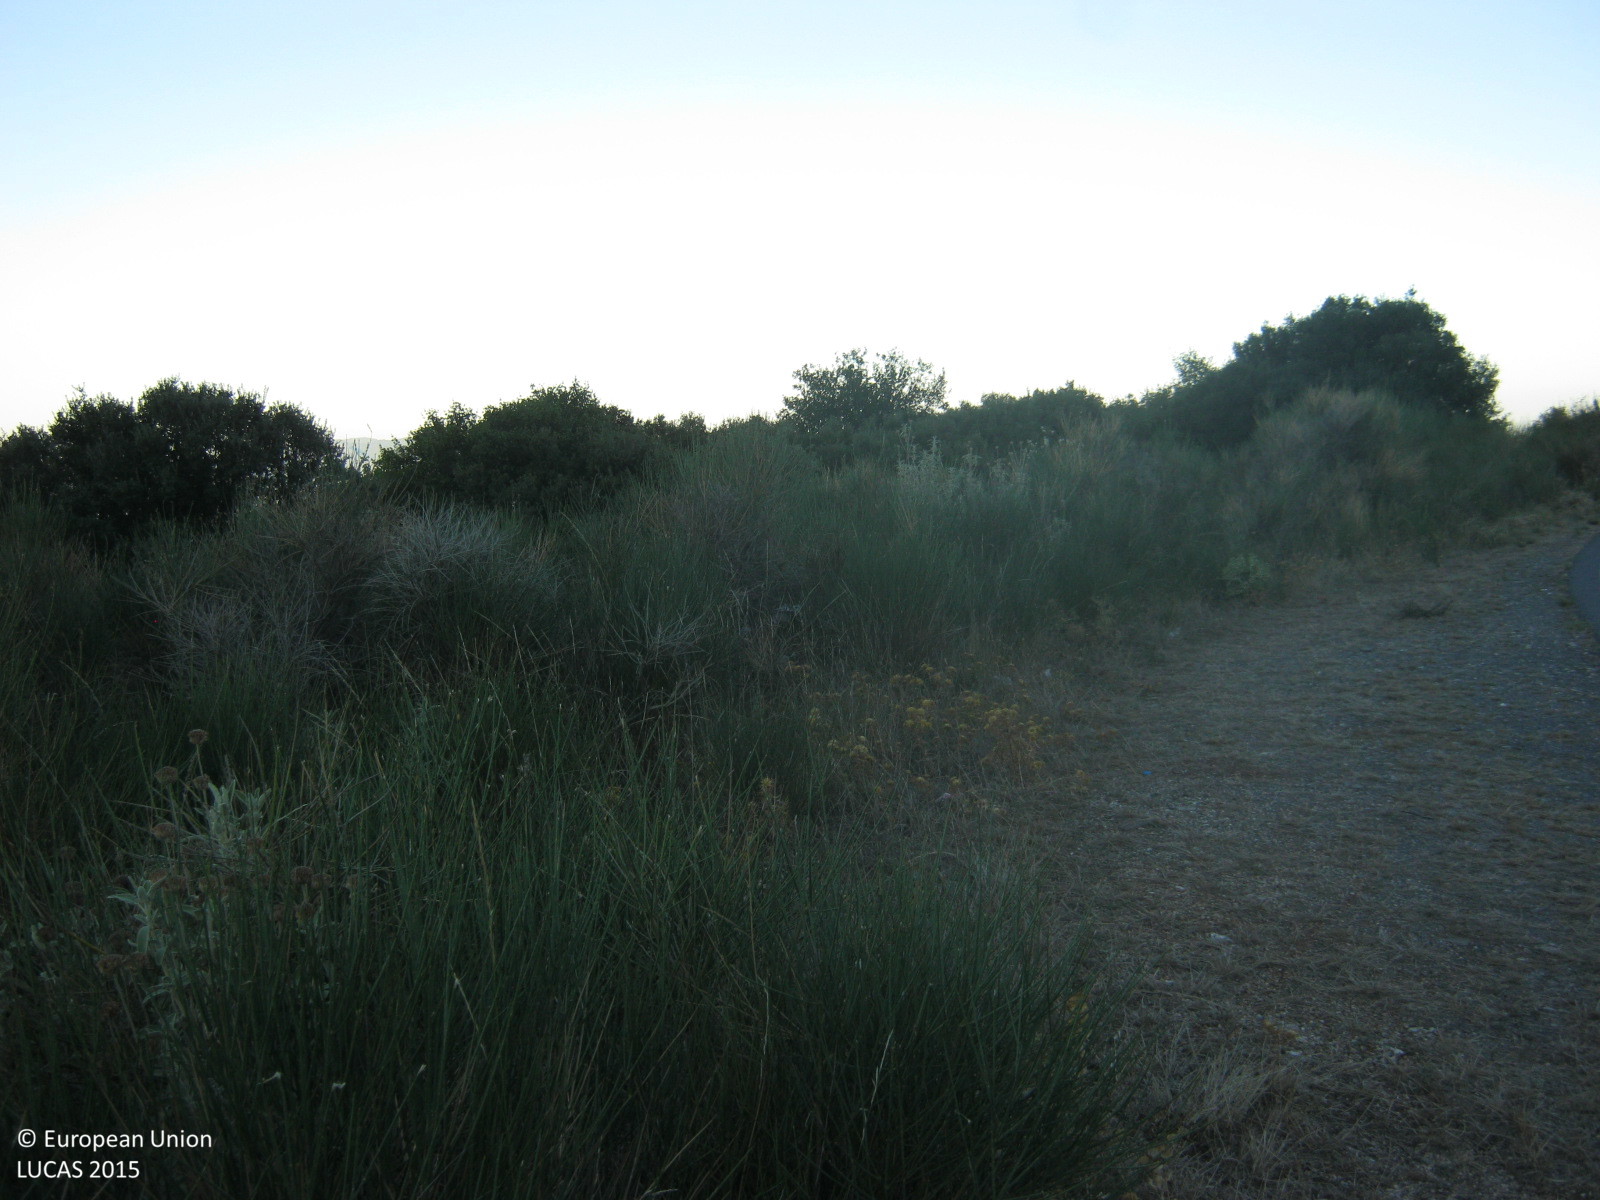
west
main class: Shrubland
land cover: Shrubland with sparse tree cover
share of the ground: > 75 %
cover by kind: shrubs 95 %, broadleaved forest trees 5 %
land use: Semi-natural and natural areas not in use
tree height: > 5 m
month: September
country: GR
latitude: 37.5920
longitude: 21.9767
